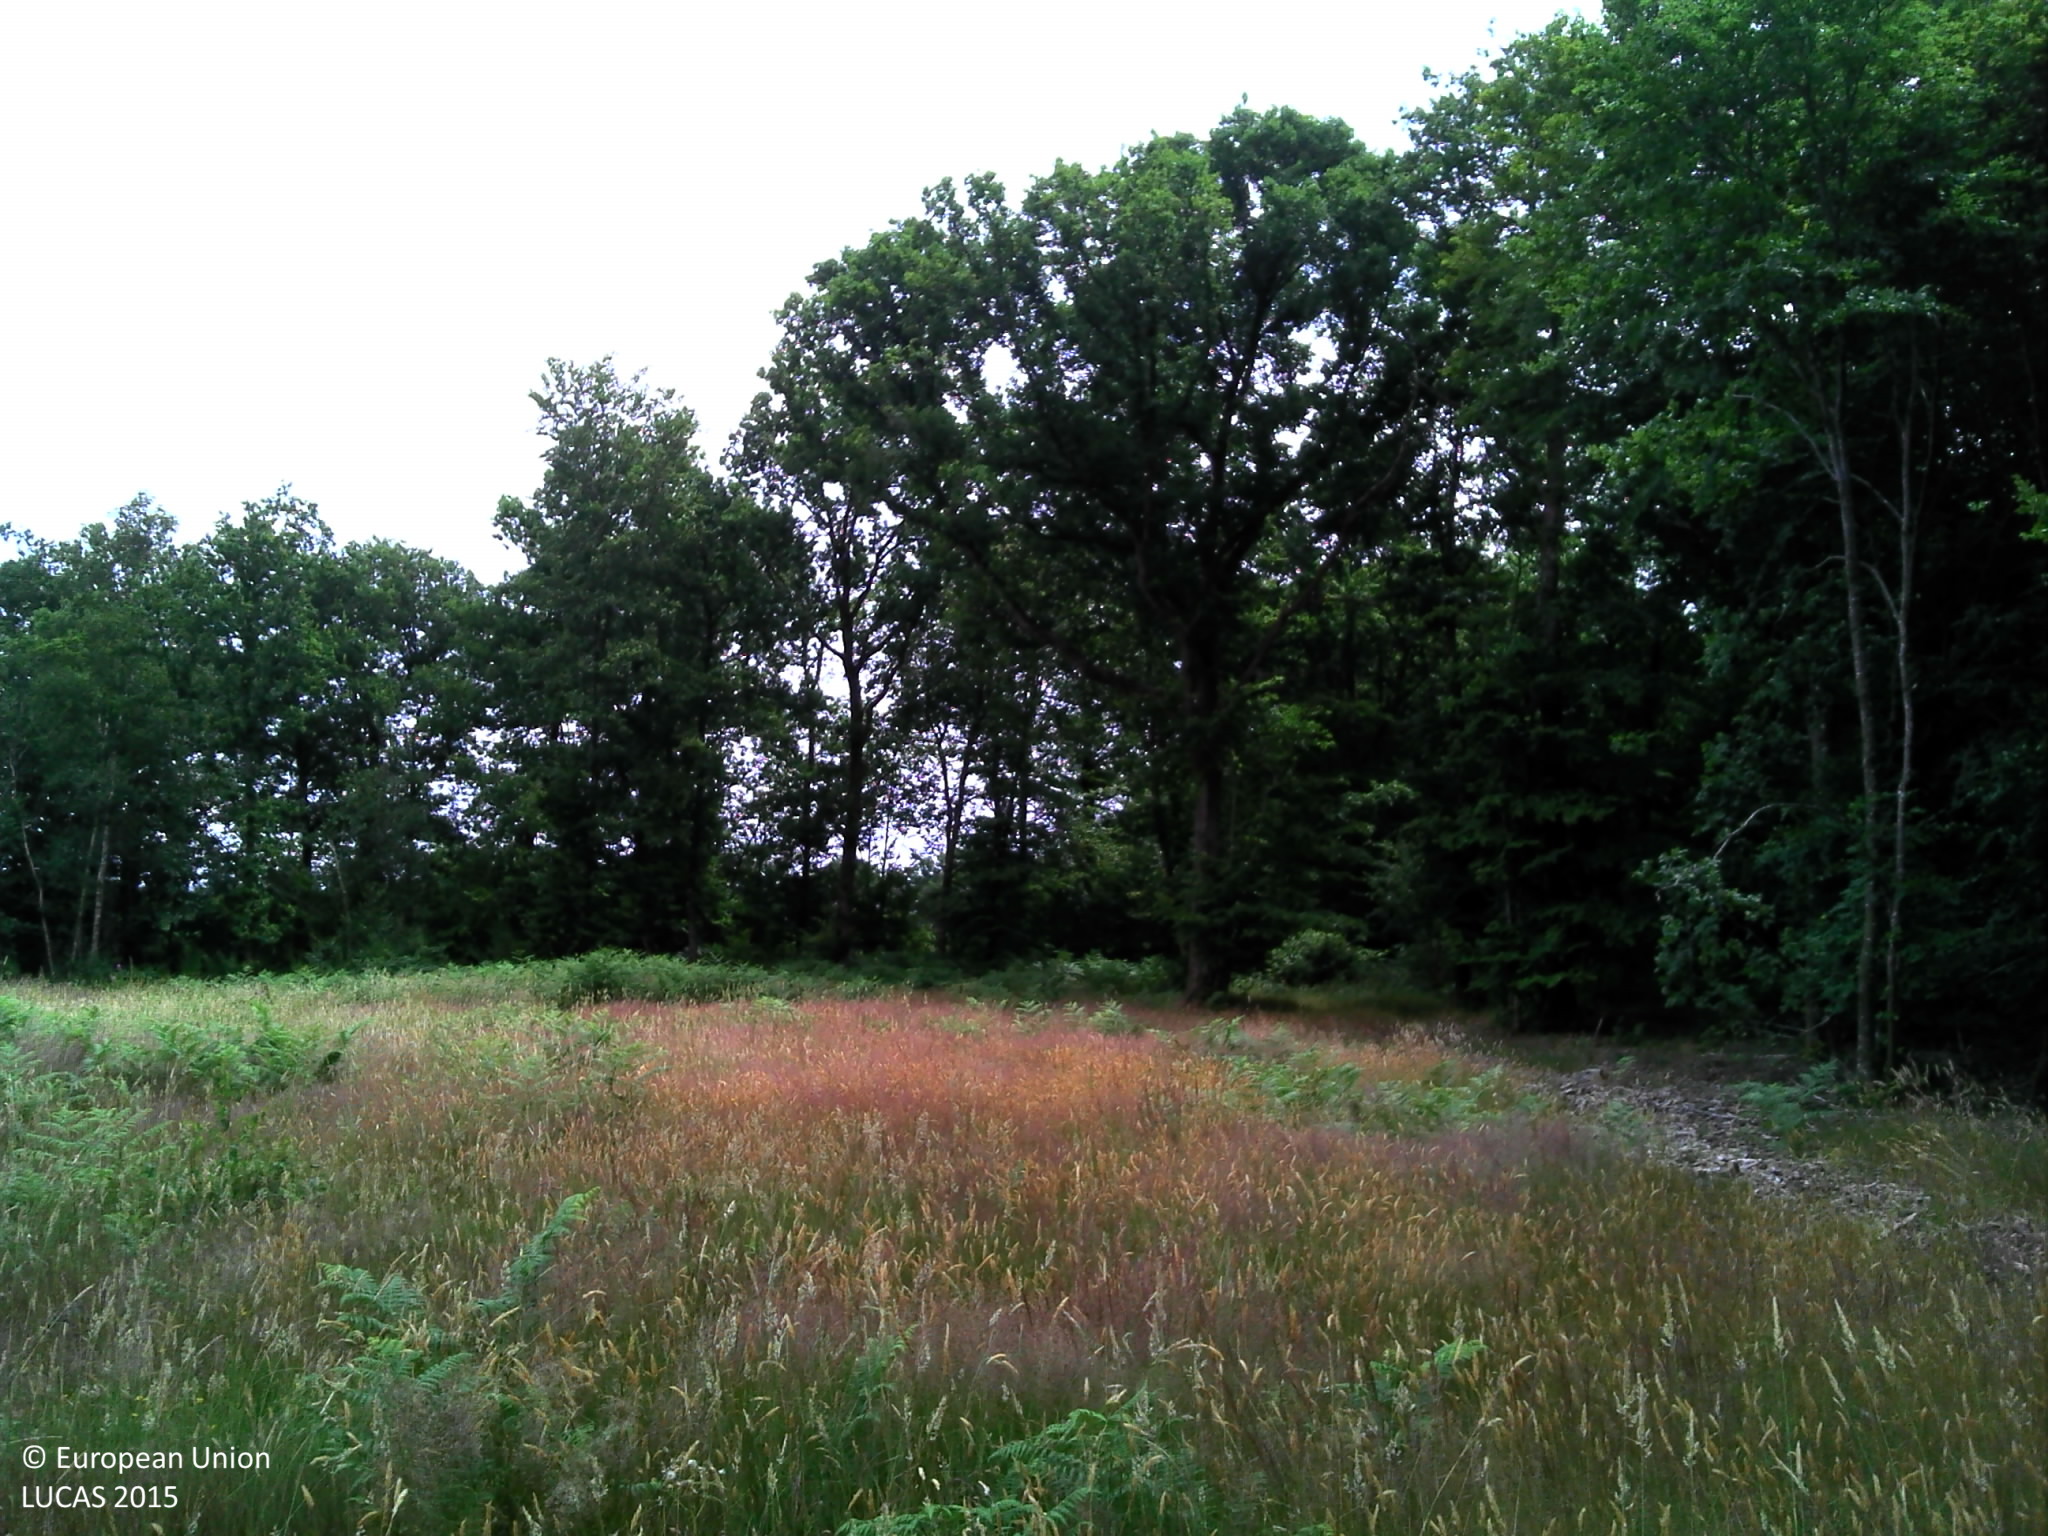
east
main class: Grassland
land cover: Spontaneously vegetated surfaces
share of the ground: > 75 %
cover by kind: herbaceous plants 75 %, unconsolidated bare surface 20 %, shrubs 5 %
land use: Forestry
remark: Clear cut
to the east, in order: Spontaneously vegetated surfaces; Broadleaved woodland; Tracks; Broadleaved woodland
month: July
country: FR
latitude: 48.4335
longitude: -2.3725
